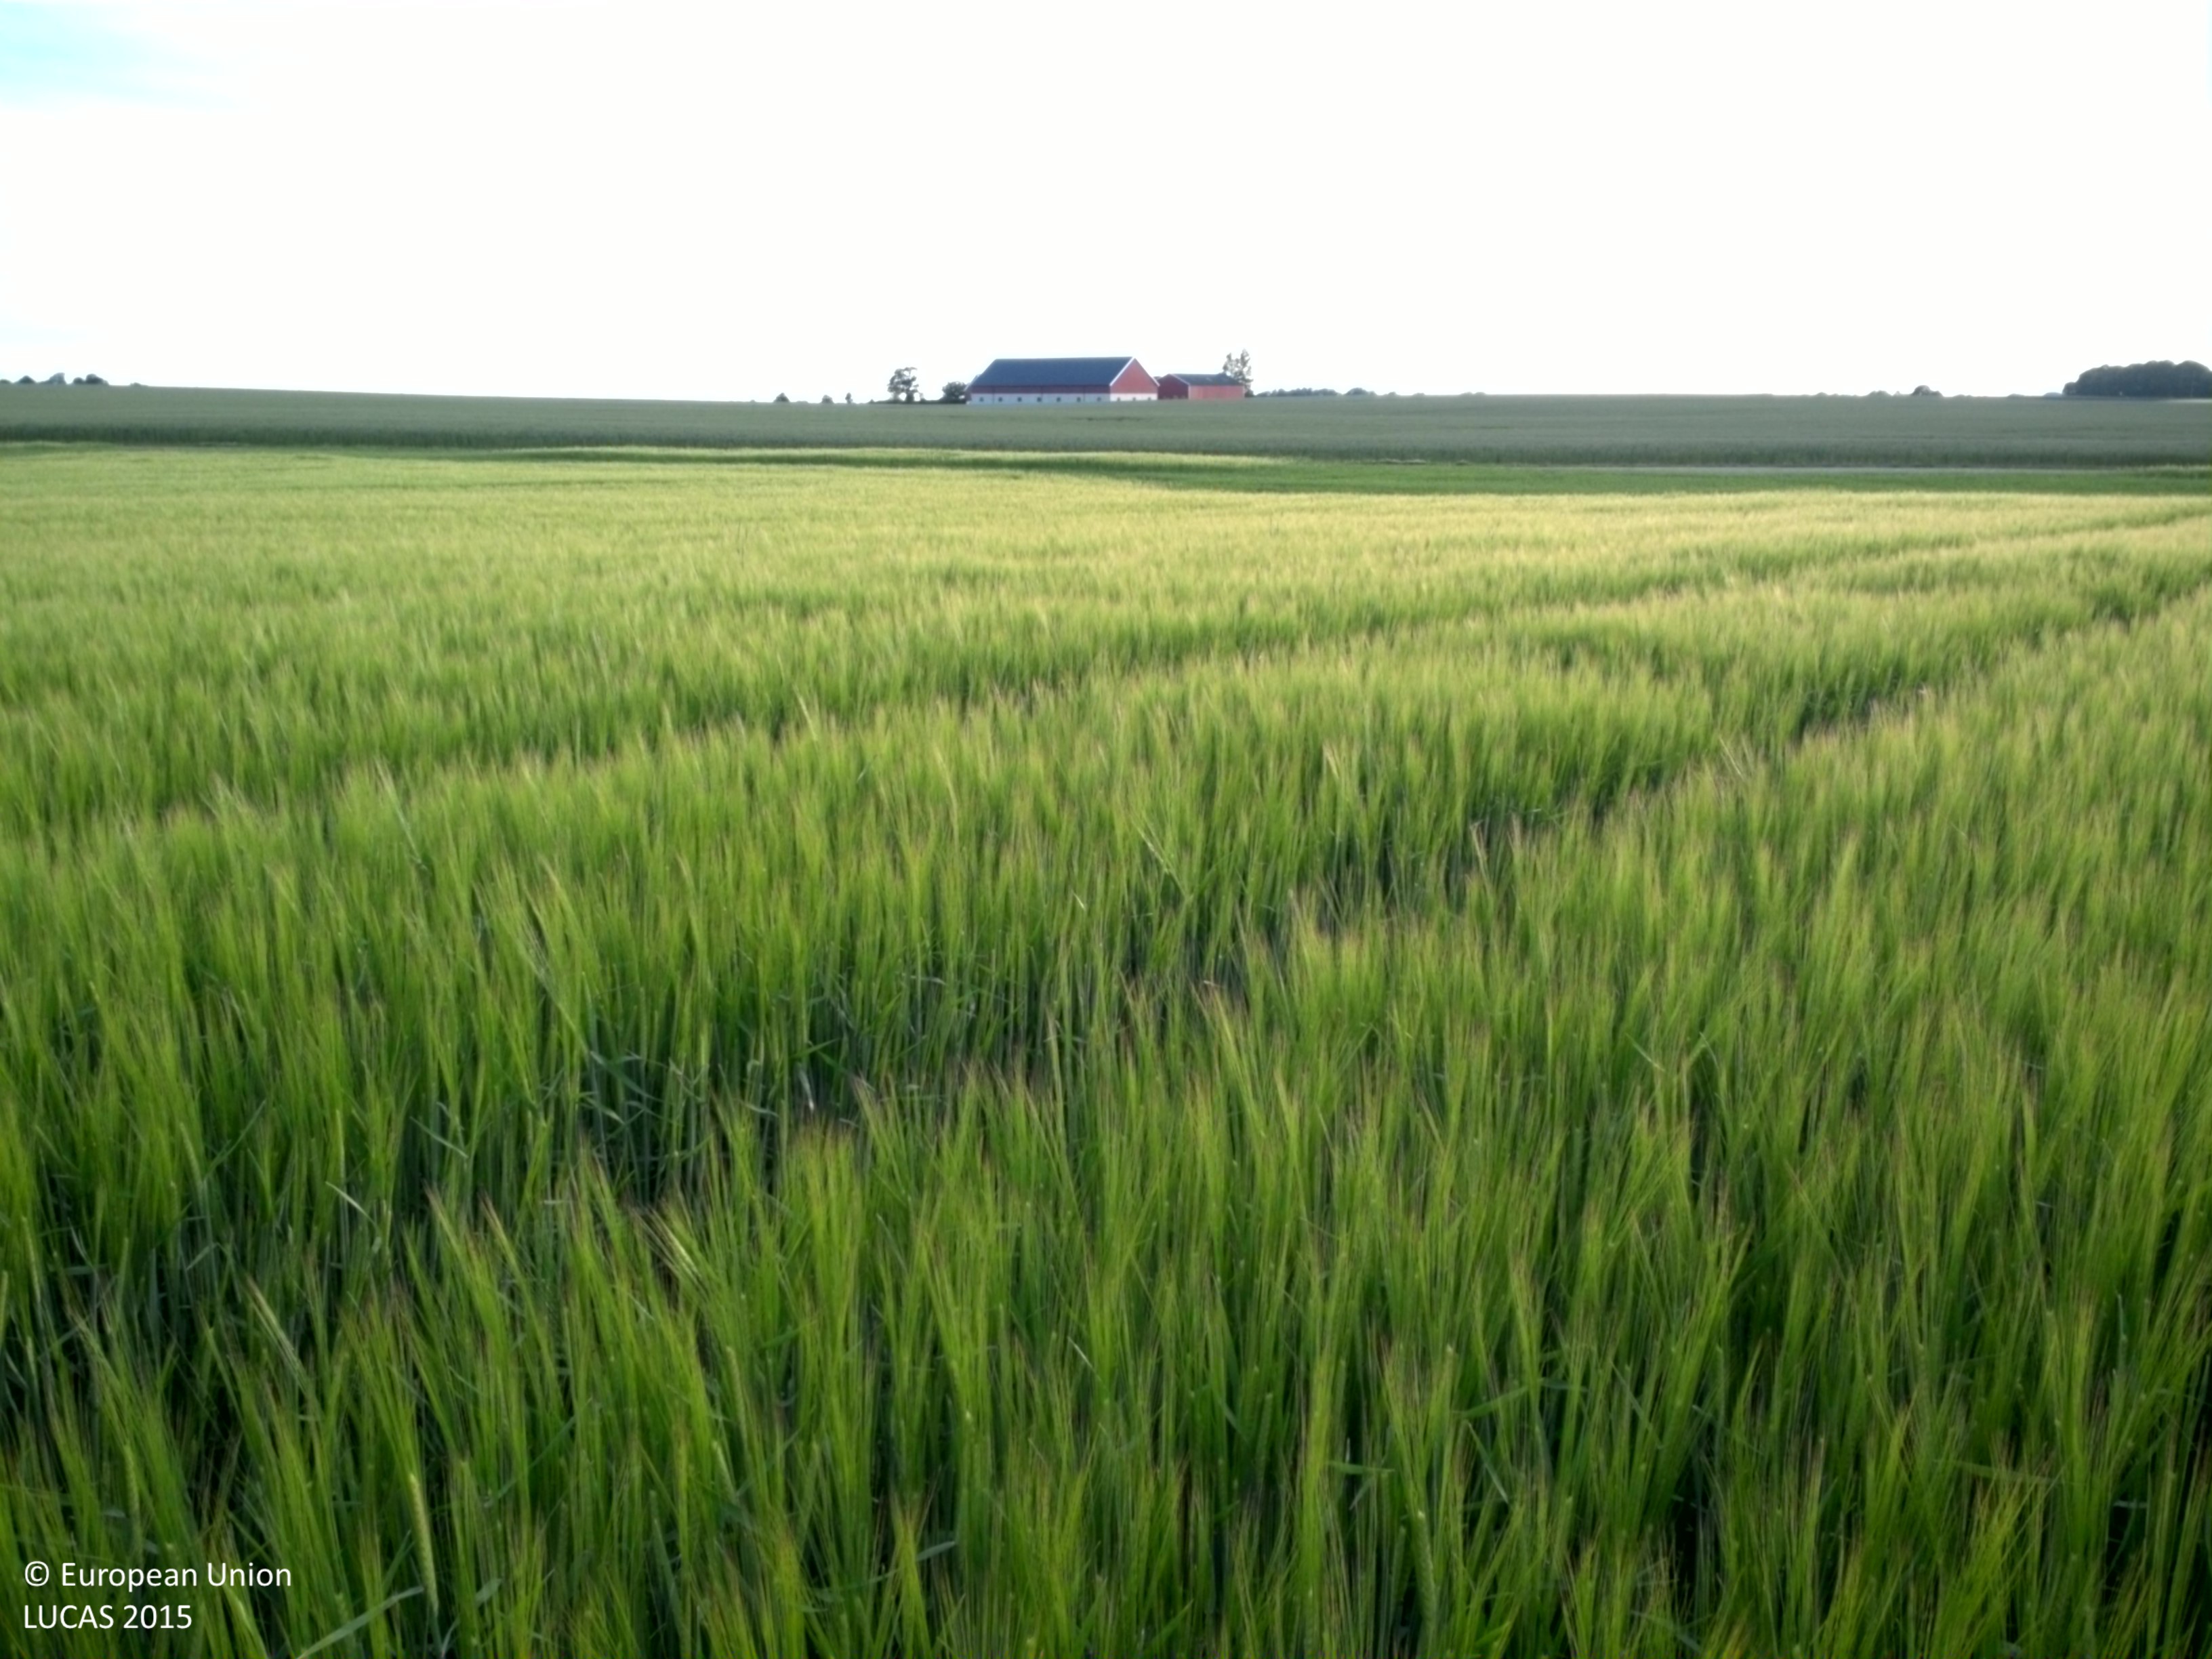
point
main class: Cropland
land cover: Barley
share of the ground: > 75 %
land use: Agriculture (excluding fallow land and kitchen gardens)
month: June
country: SE
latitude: 55.4305
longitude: 13.1113
